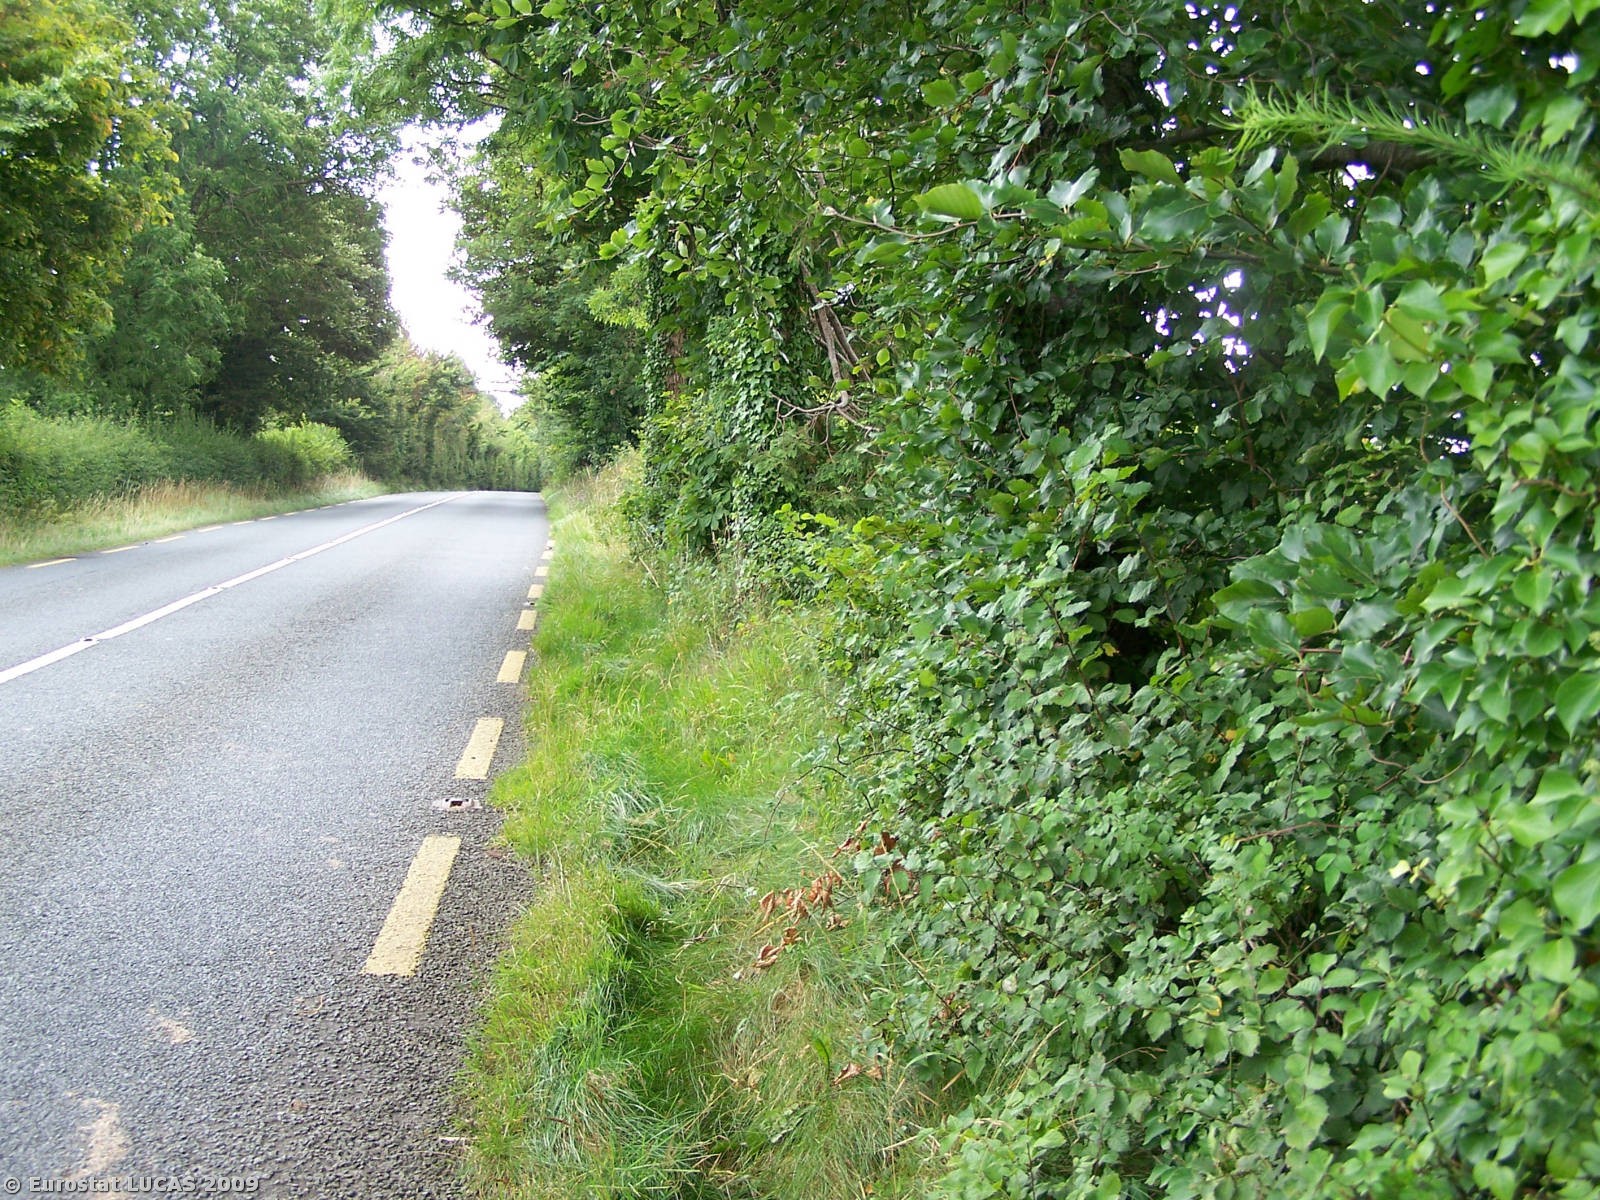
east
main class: Grassland
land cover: Grassland without tree/shrub cover
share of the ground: > 75 %
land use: Agriculture (excluding fallow land and kitchen gardens)
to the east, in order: Grassland without tree/shrub cover; Abandoned hedges; Grassland without tree/shrub cover
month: August
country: IE
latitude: 52.1432
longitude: -8.8378
